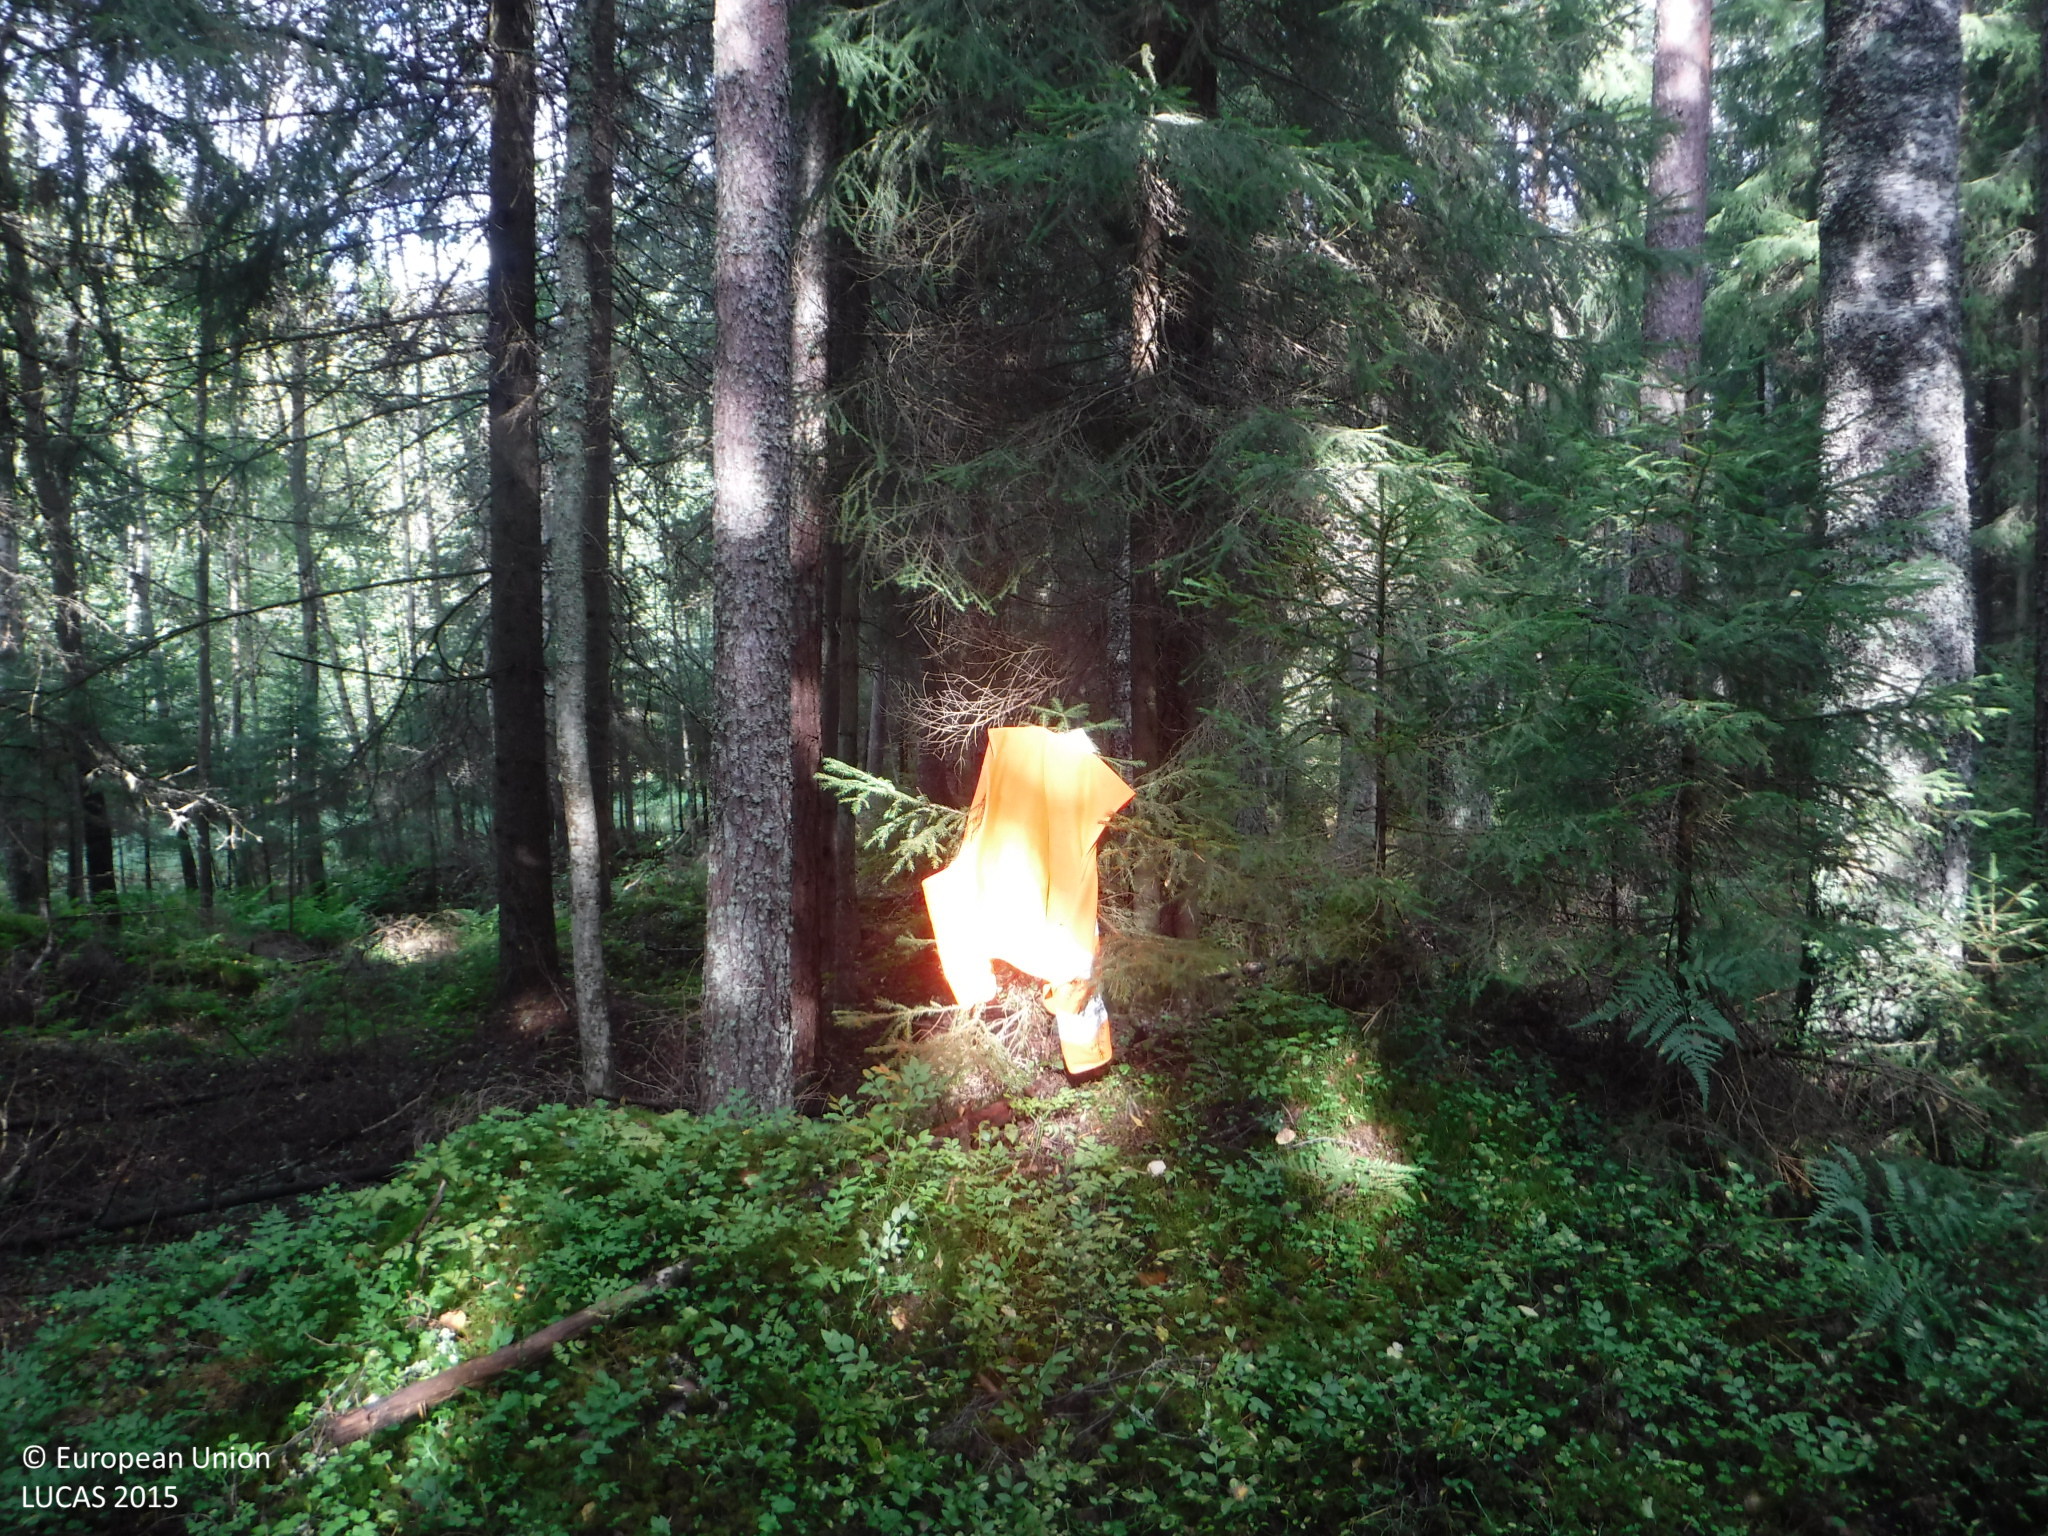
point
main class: Woodland
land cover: Other mixed woodland
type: boreal forest
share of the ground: > 75 %
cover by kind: coniferous forest trees 50 %, broadleaved forest trees 25 %, lichens and mosses 15 %, shrubs 10 %
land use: Forestry
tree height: > 5 m
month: September
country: FI
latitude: 61.4004
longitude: 23.0503
